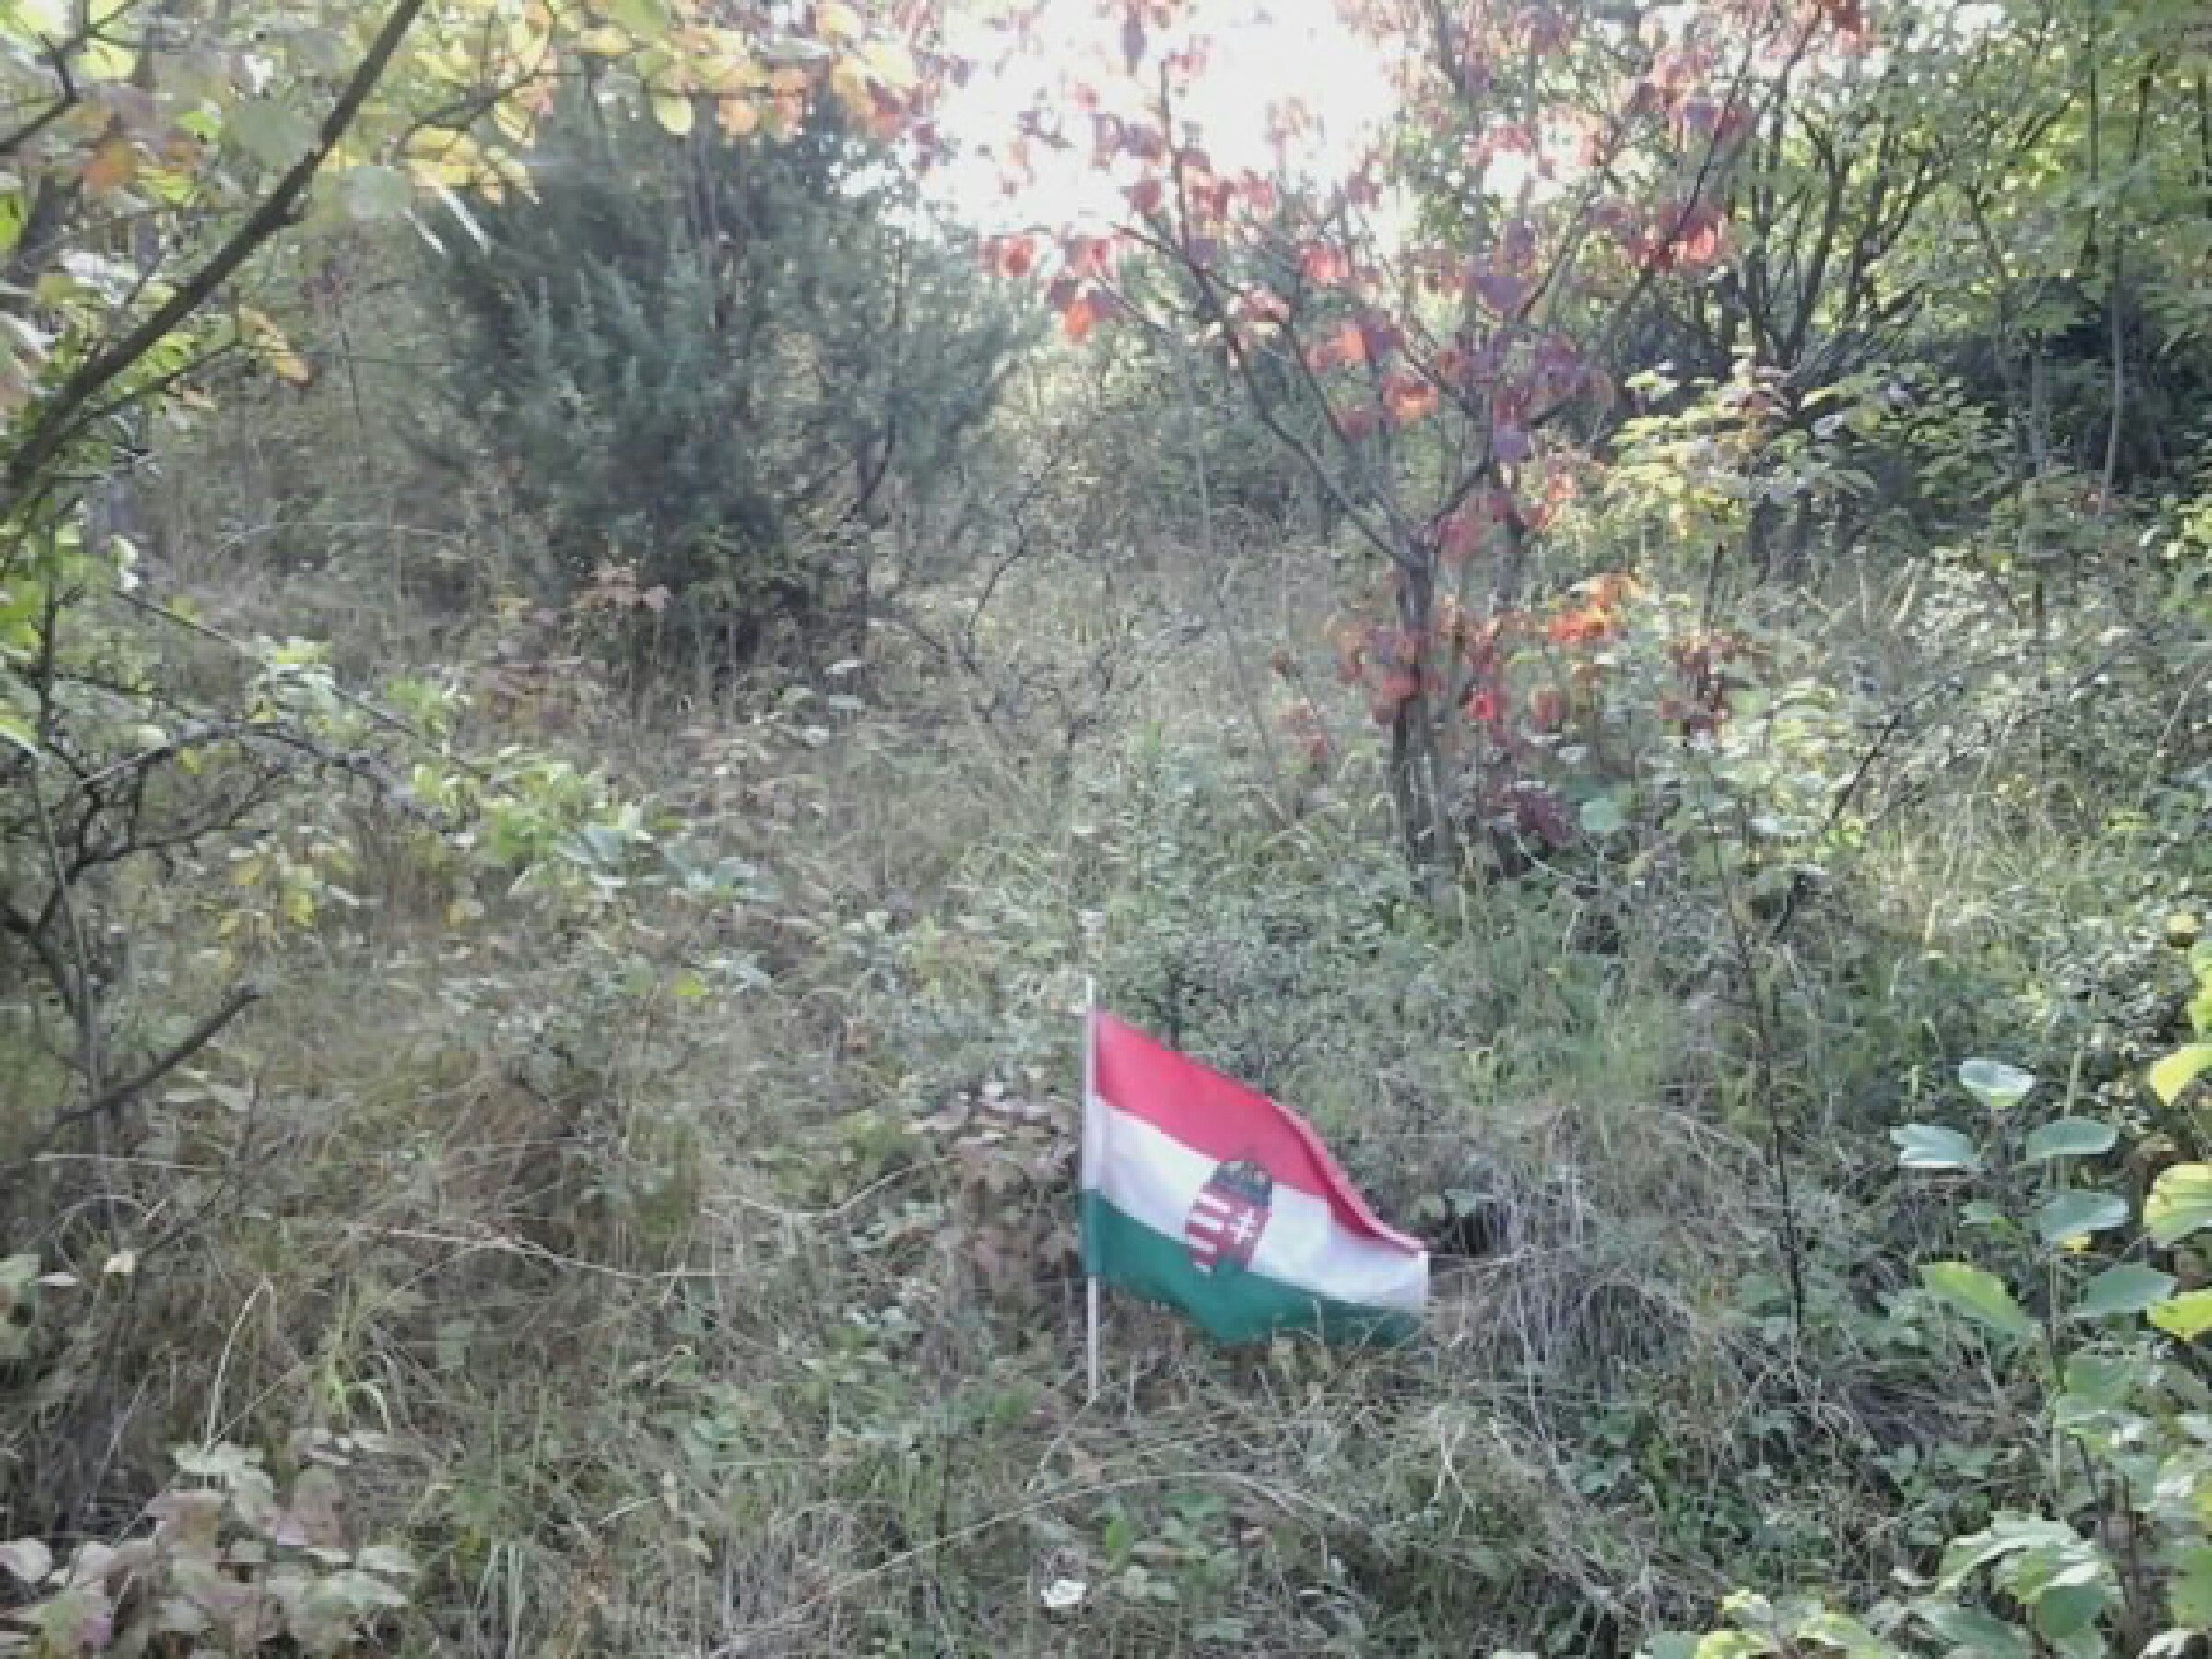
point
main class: Shrubland
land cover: Shrubland with sparse tree cover
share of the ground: > 75 %
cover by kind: shrubs 80 %, herbaceous plants 15 %, broadleaved forest trees 5 %
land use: Semi-natural and natural areas not in use
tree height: > 5 m
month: August
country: HU
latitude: 48.0519
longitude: 19.4546
